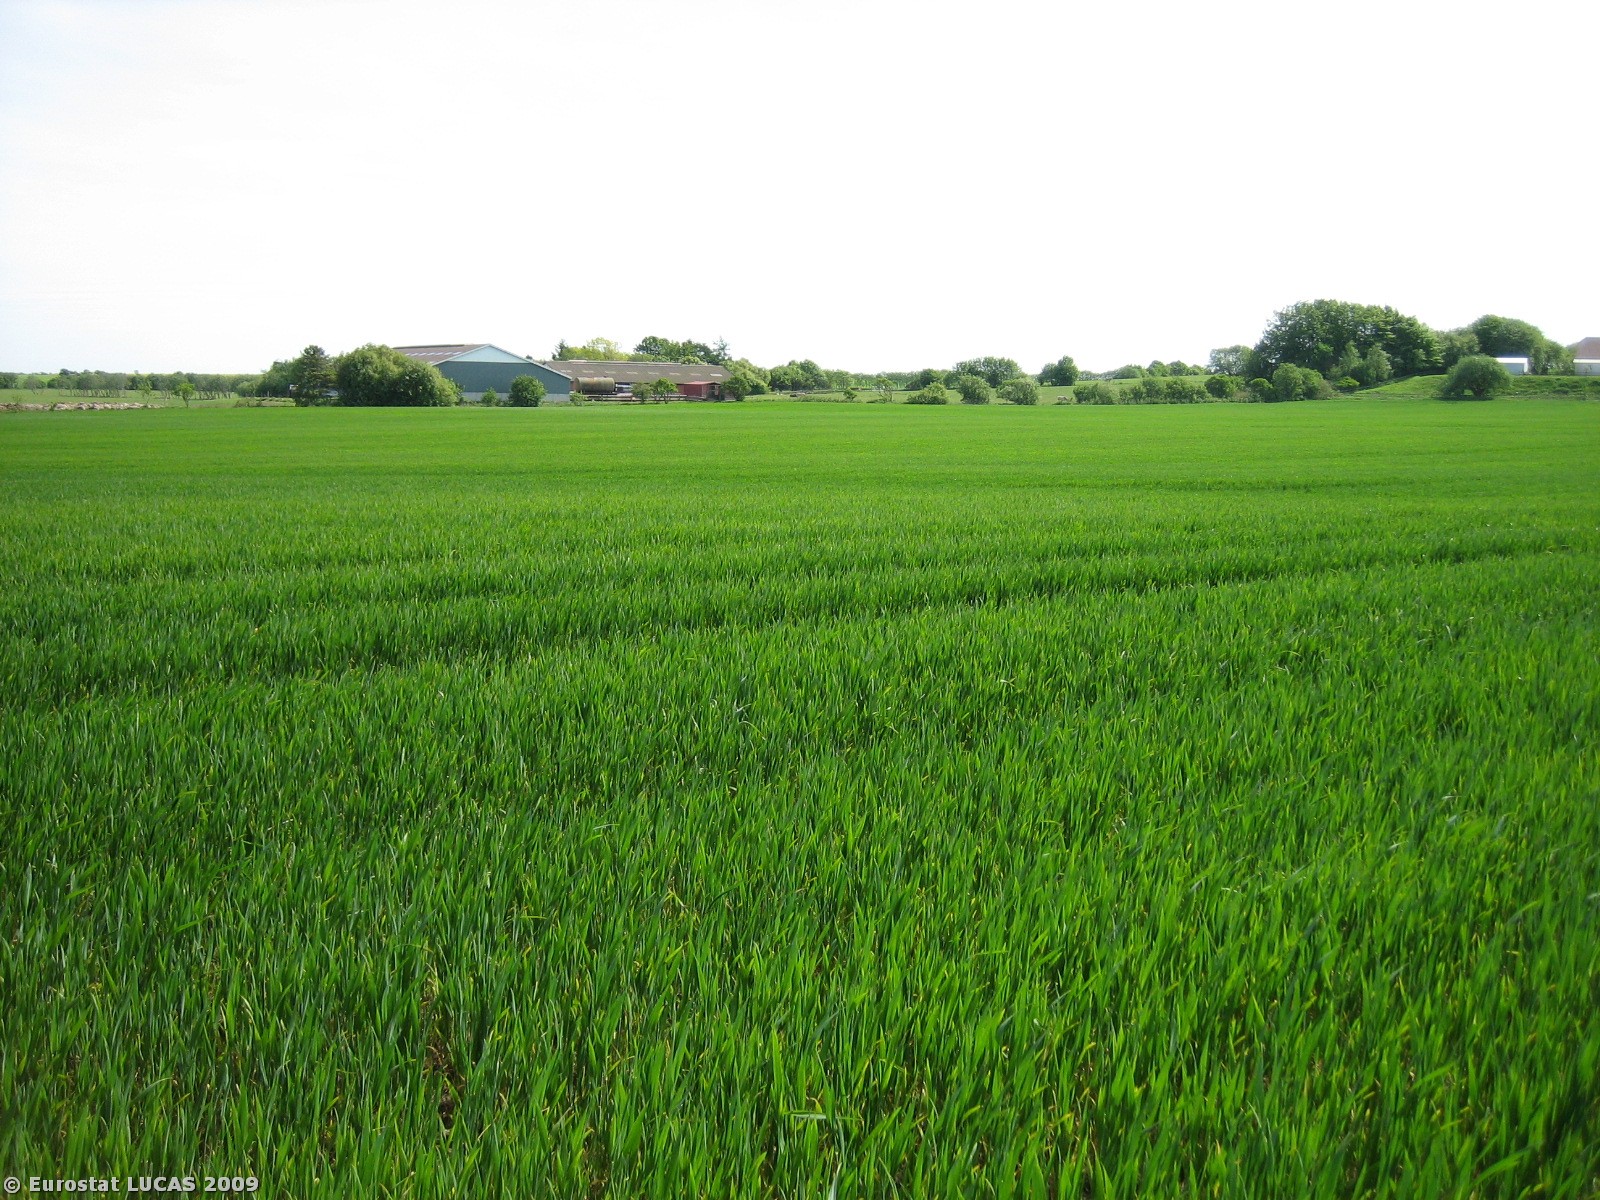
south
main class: Cropland
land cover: Barley
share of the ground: > 75 %
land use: Agriculture (excluding fallow land and kitchen gardens)
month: May
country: DK
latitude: 55.9990
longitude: 8.4783
